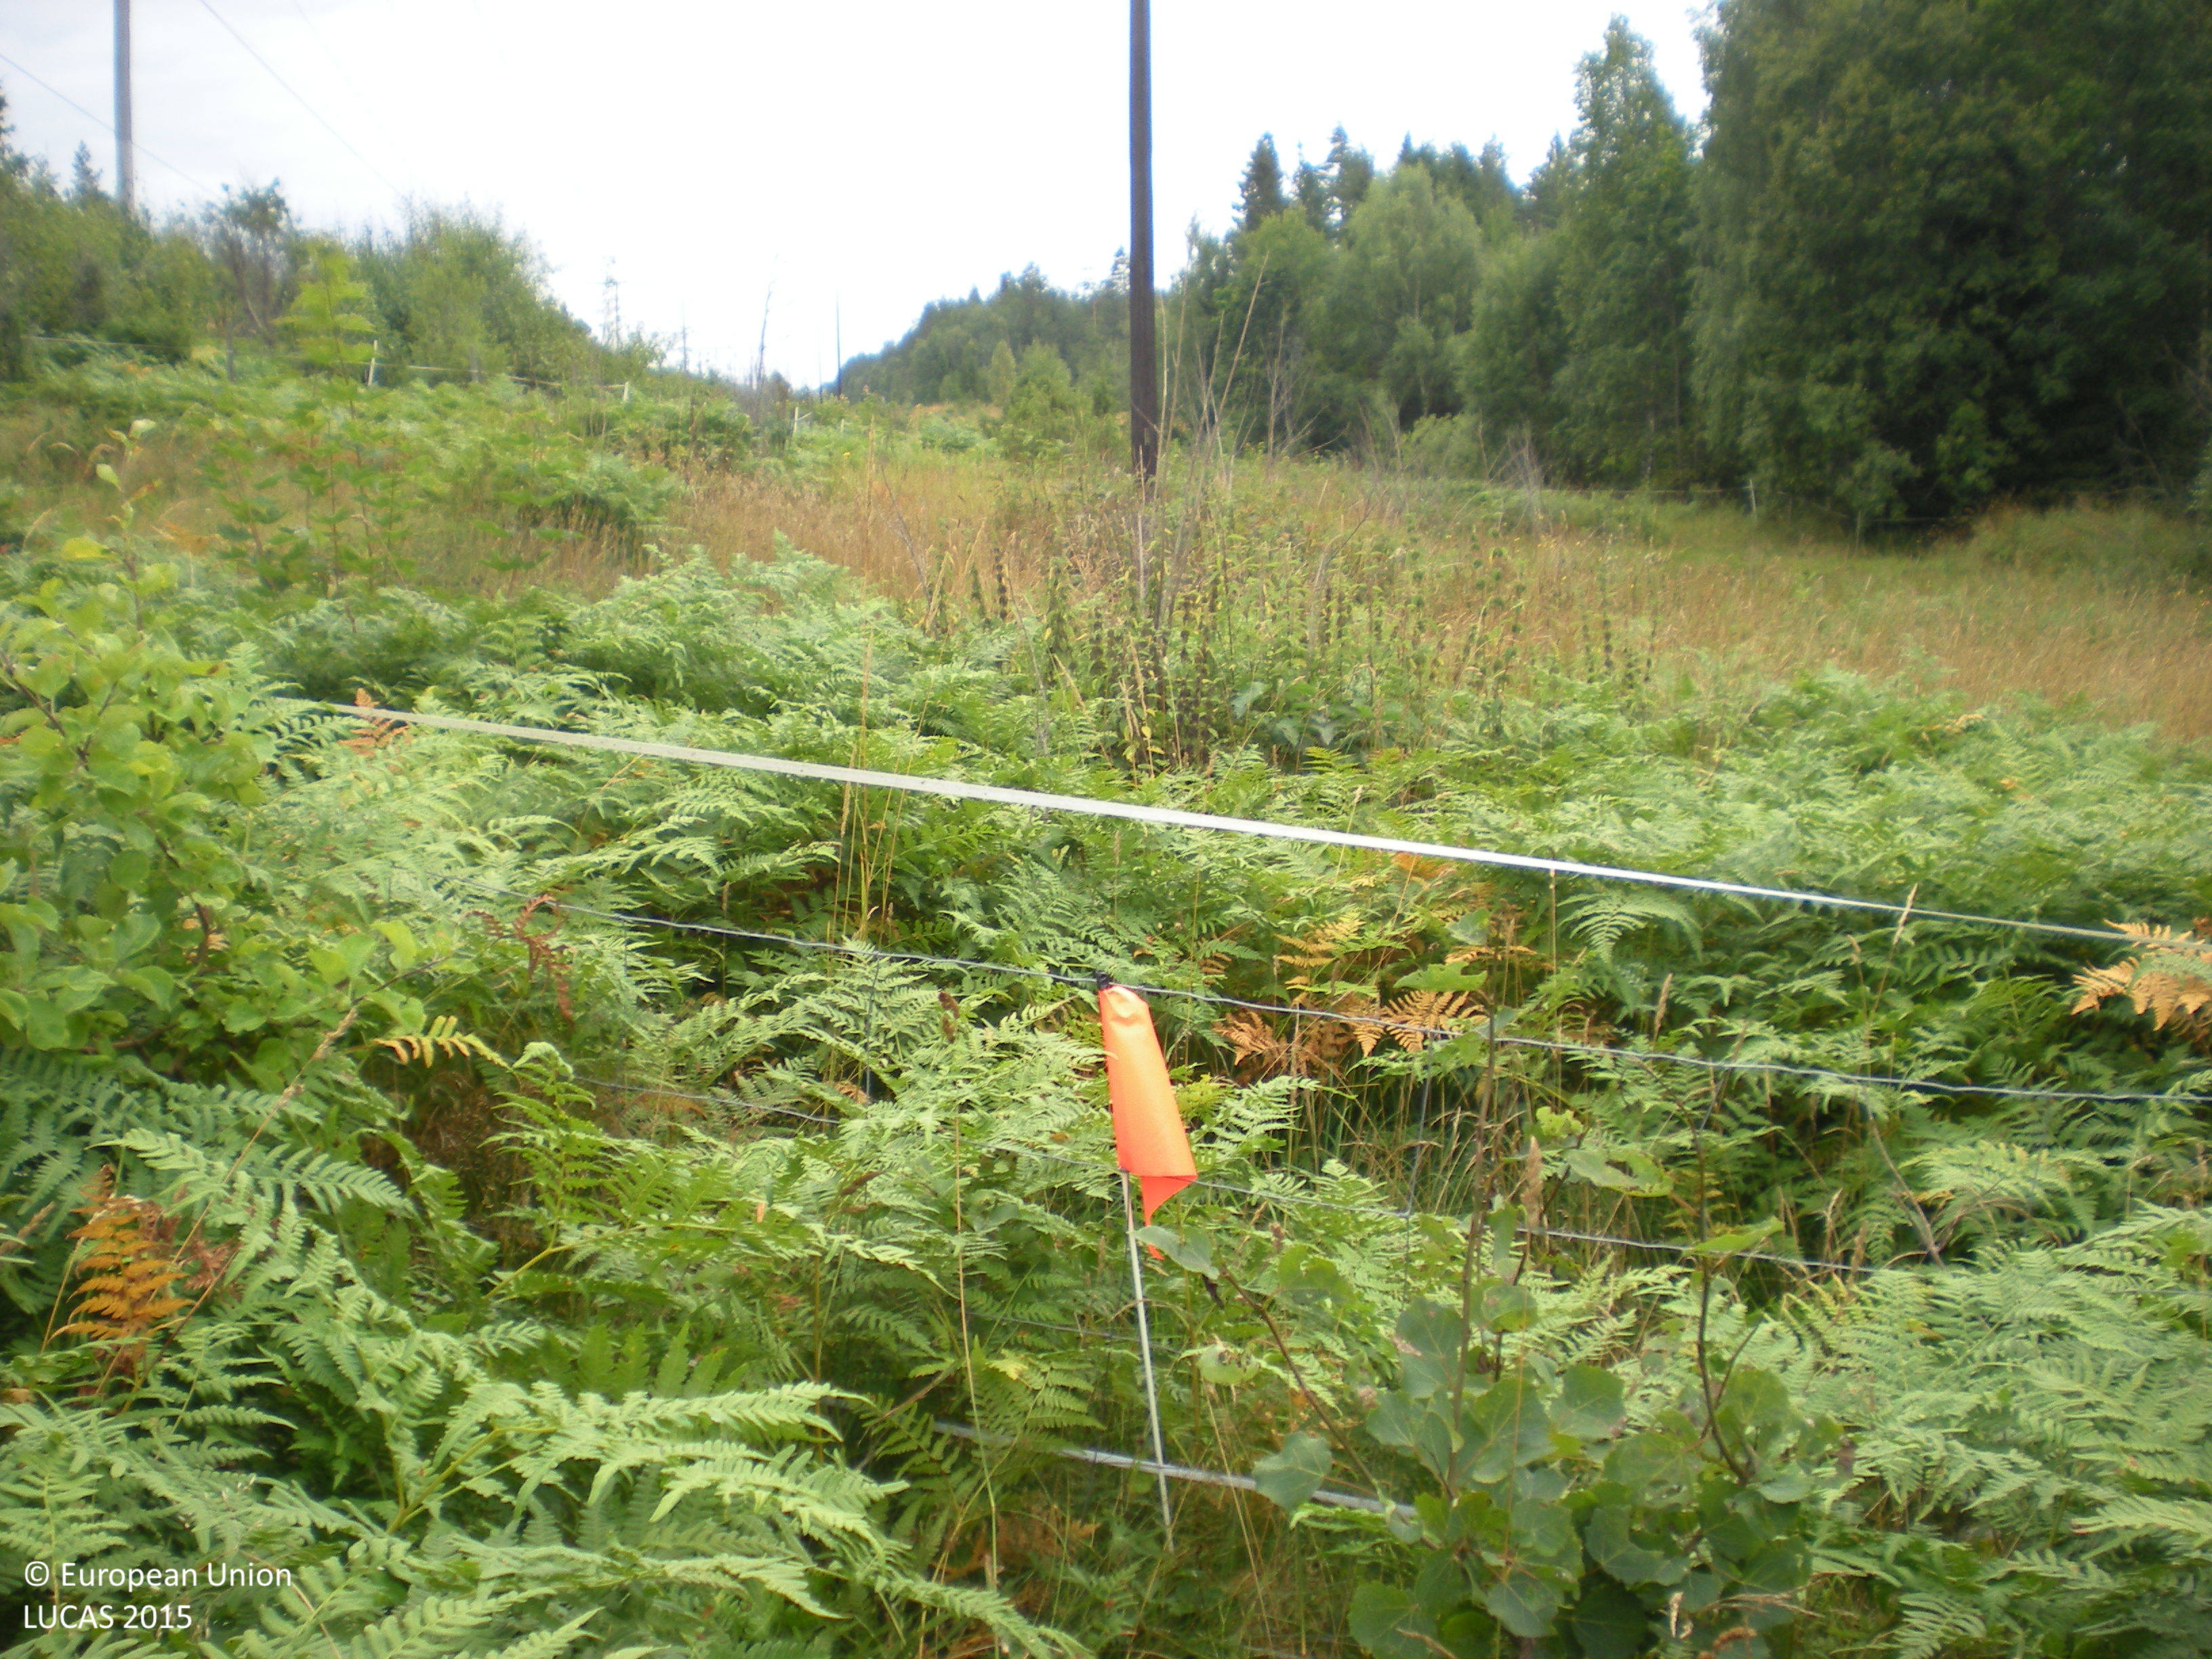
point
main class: Woodland
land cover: Broadleaved woodland
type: hemiboreal forest and nemoral coniferous forest and mixed broadleaved-coniferous forest
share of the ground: 10 - 25 %
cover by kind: herbaceous plants 75 %, broadleaved forest trees 15 %, shrubs 10 %
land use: Forestry
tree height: < 5 m
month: August
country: SE
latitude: 60.5022
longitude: 17.2181
